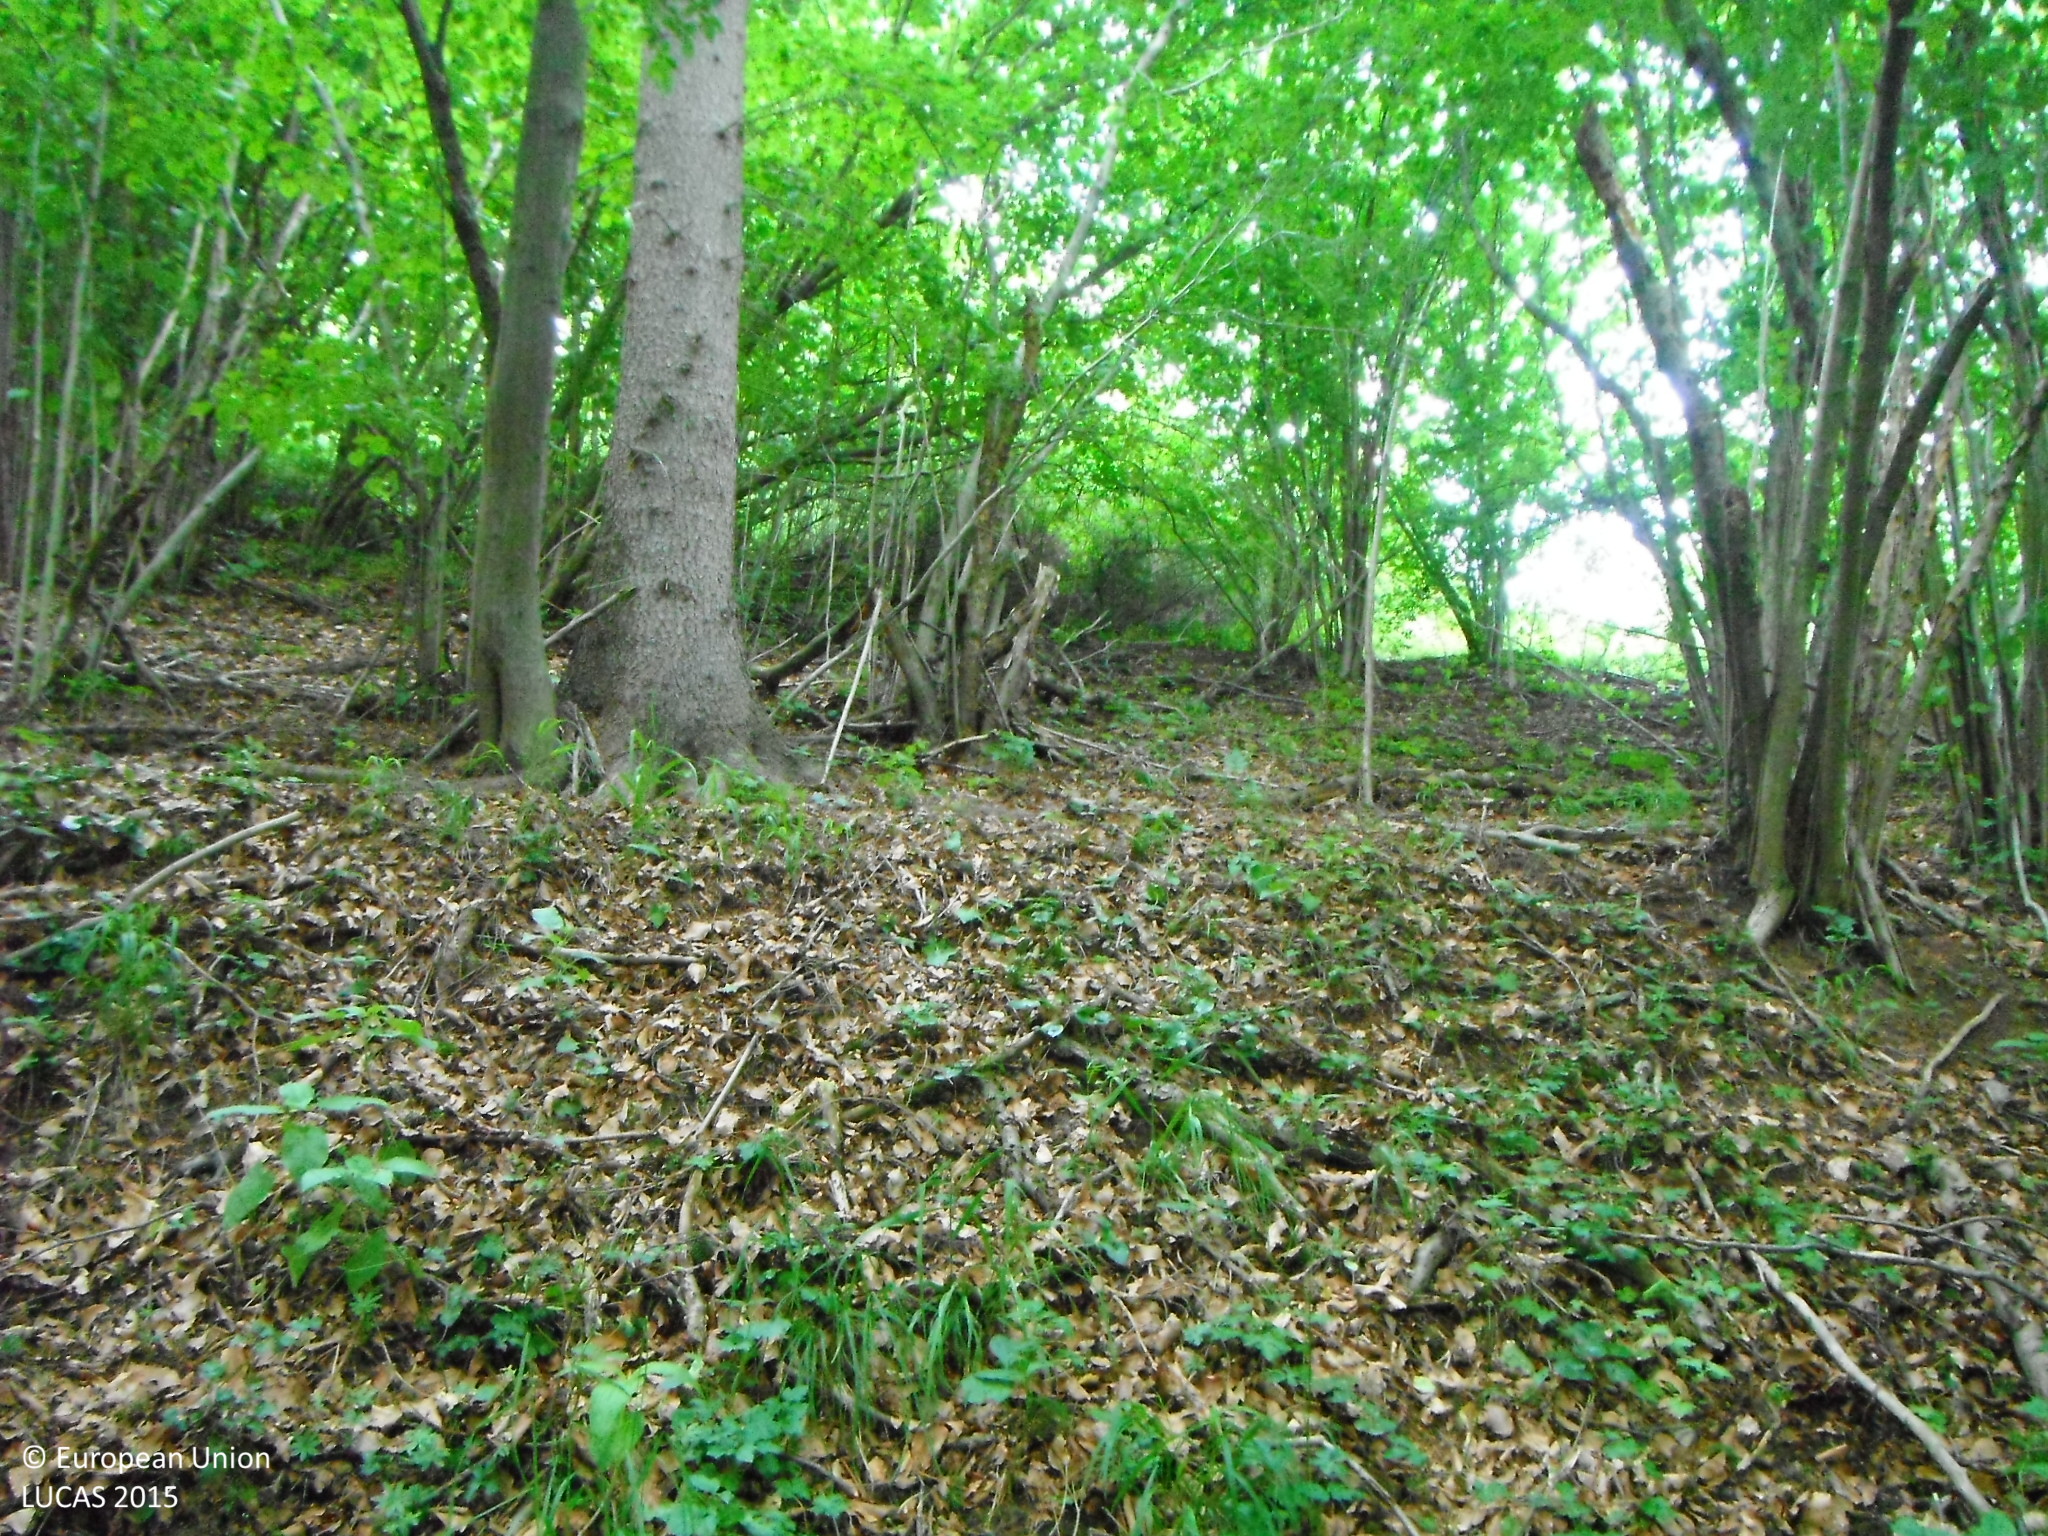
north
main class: Woodland
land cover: Spruce dominated mixed woodland
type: mountainous beech forest
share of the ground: > 75 %
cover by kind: broadleaved forest trees 70 %, coniferous forest trees 25 %, herbaceous plants 5 %
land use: Forestry
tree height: > 5 m
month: June
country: SK
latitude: 49.1824
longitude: 19.1464
